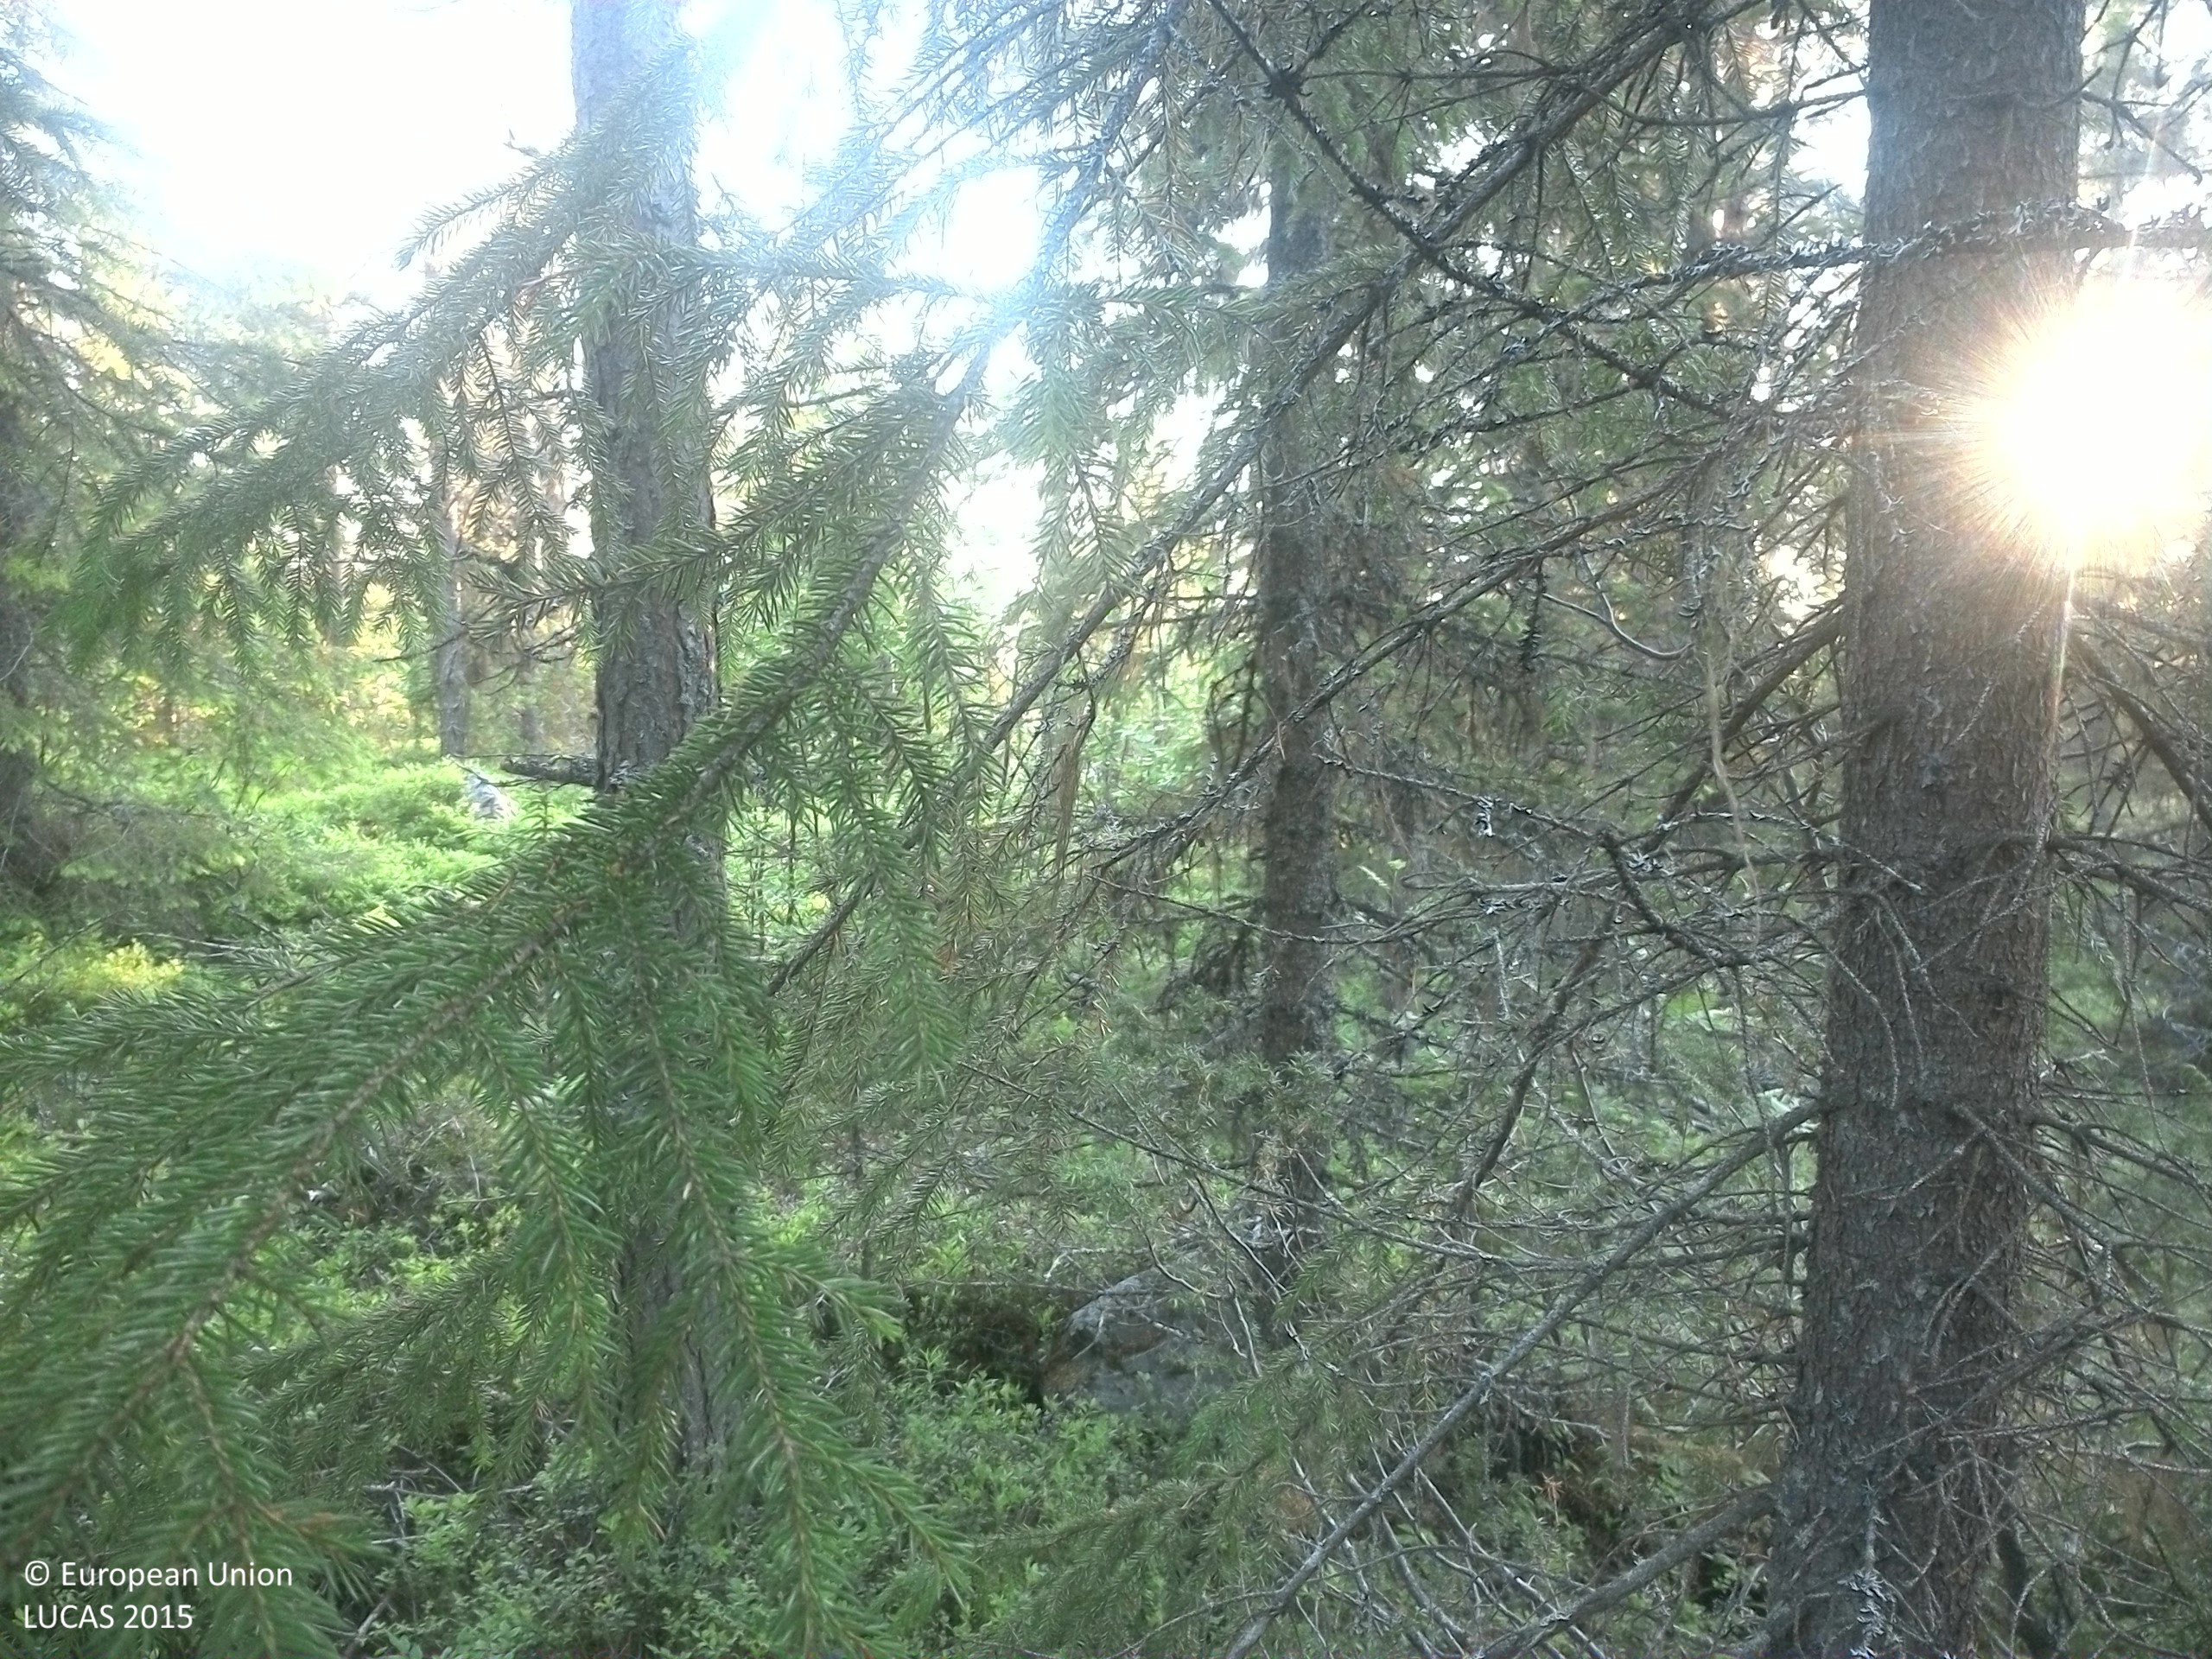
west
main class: Woodland
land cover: Other coniferous woodland
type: boreal forest
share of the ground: 50 - 75 %
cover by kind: coniferous forest trees 60 %, shrubs 30 %, broadleaved forest trees 5 %, herbaceous plants 5 %
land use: Forestry
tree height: > 5 m
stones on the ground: 25 - 50 %
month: July
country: SE
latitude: 64.5491
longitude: 15.7046
